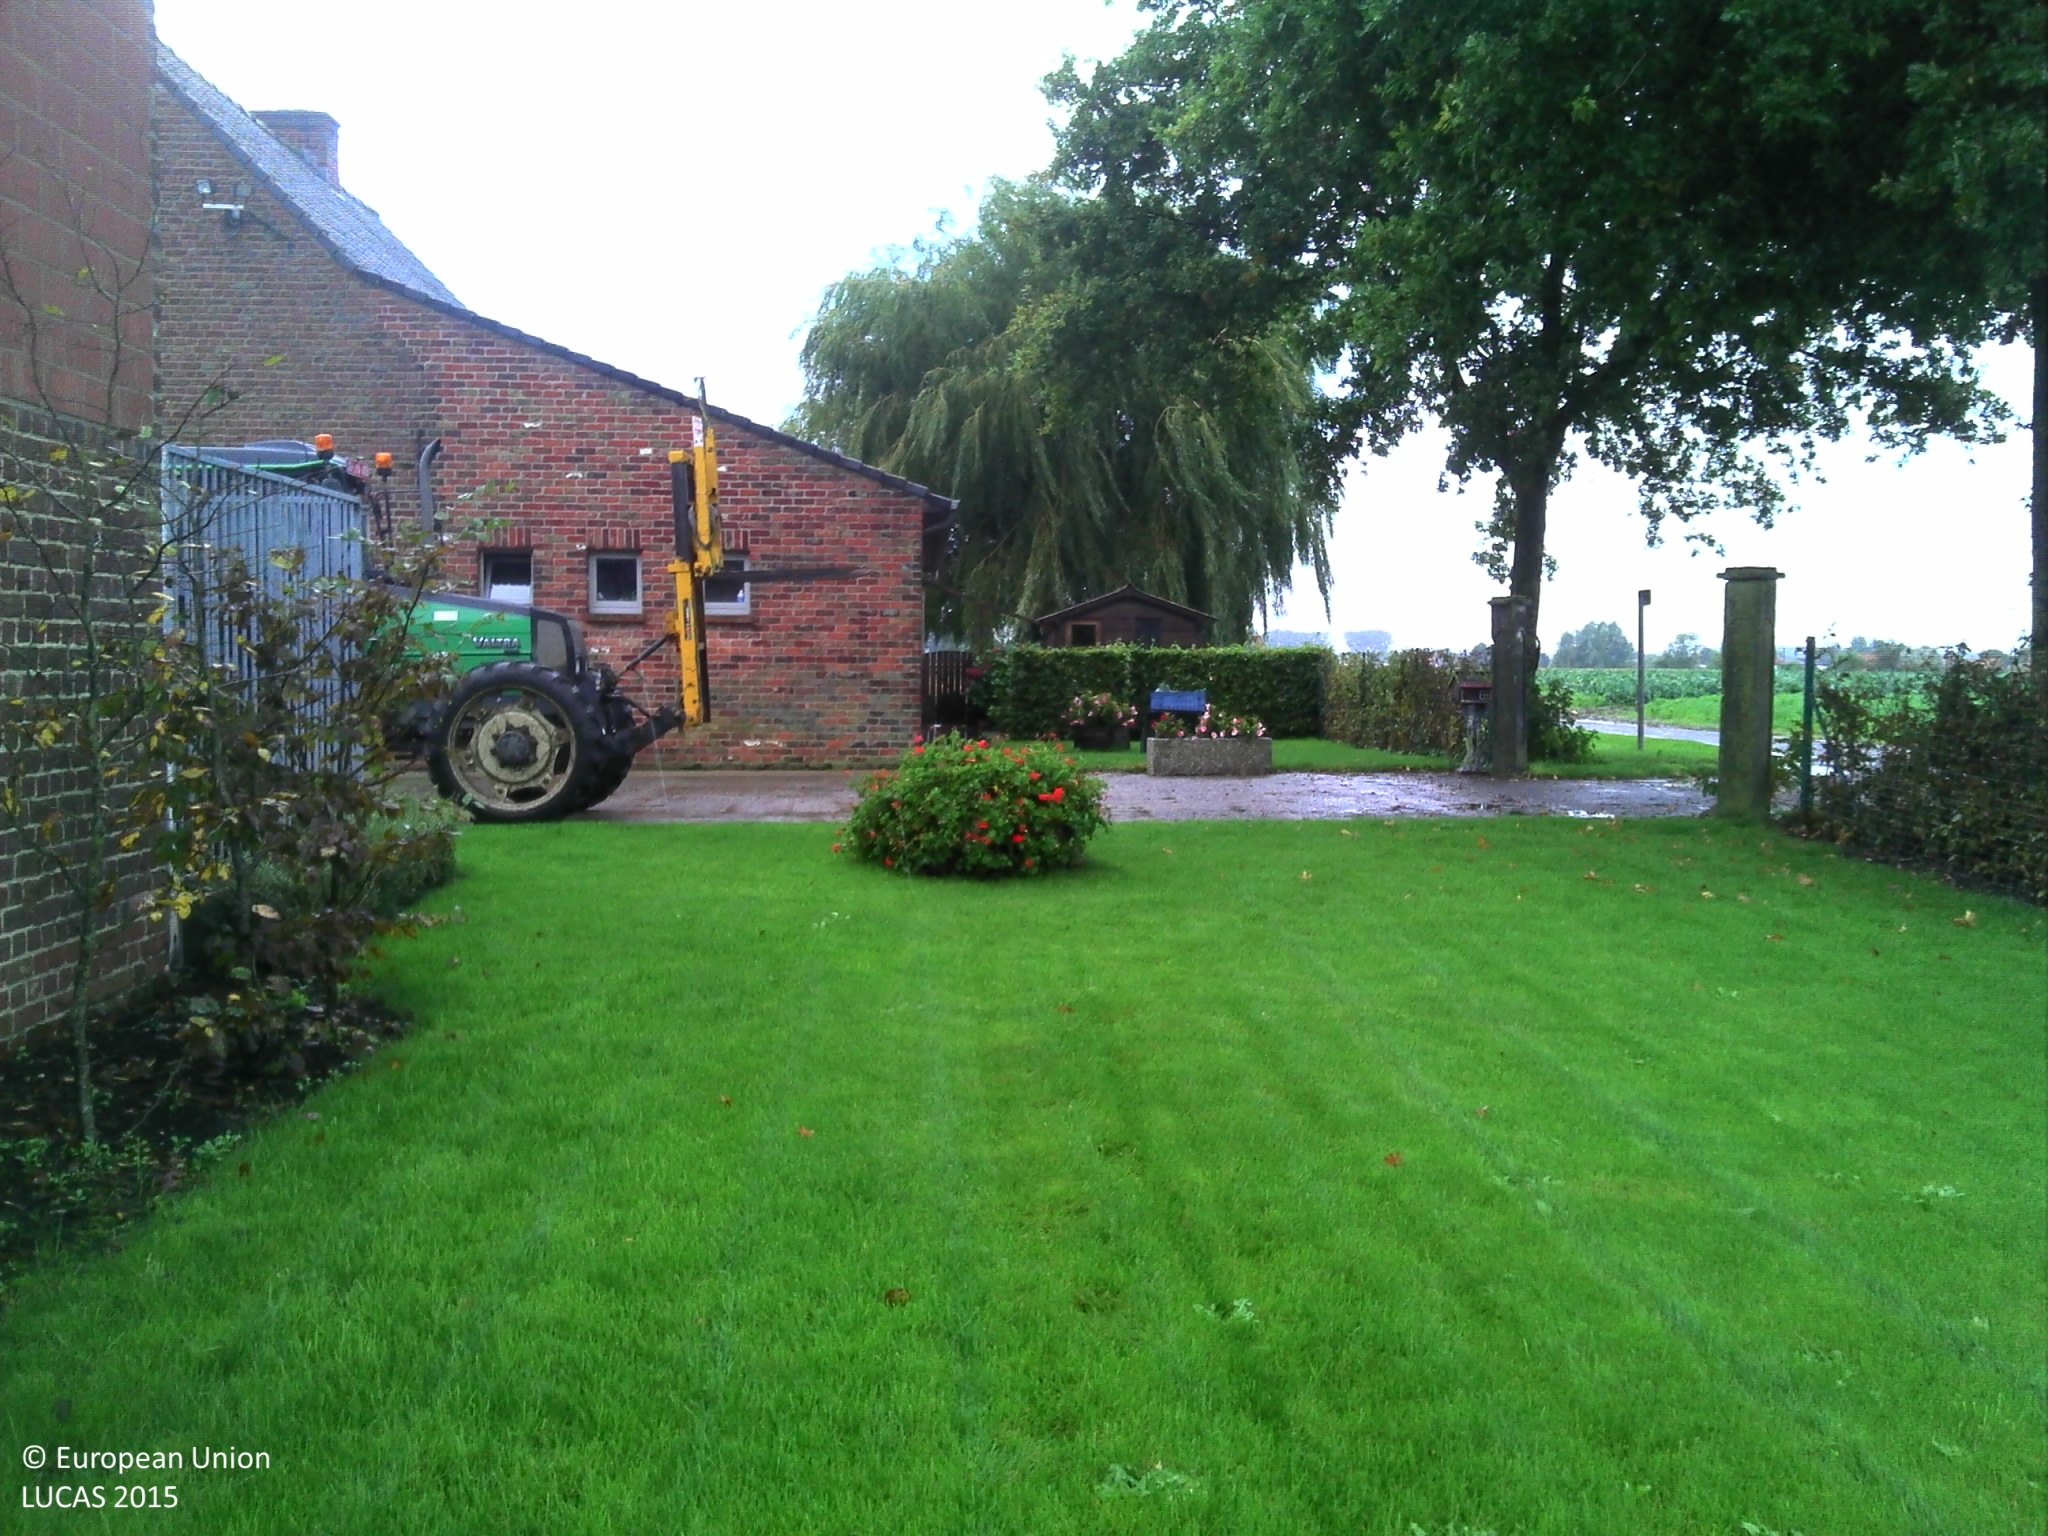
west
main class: Grassland
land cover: Grassland without tree/shrub cover
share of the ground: > 75 %
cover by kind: herbaceous plants 100 %
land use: Residential
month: October
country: BE
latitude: 50.9438
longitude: 3.0018
